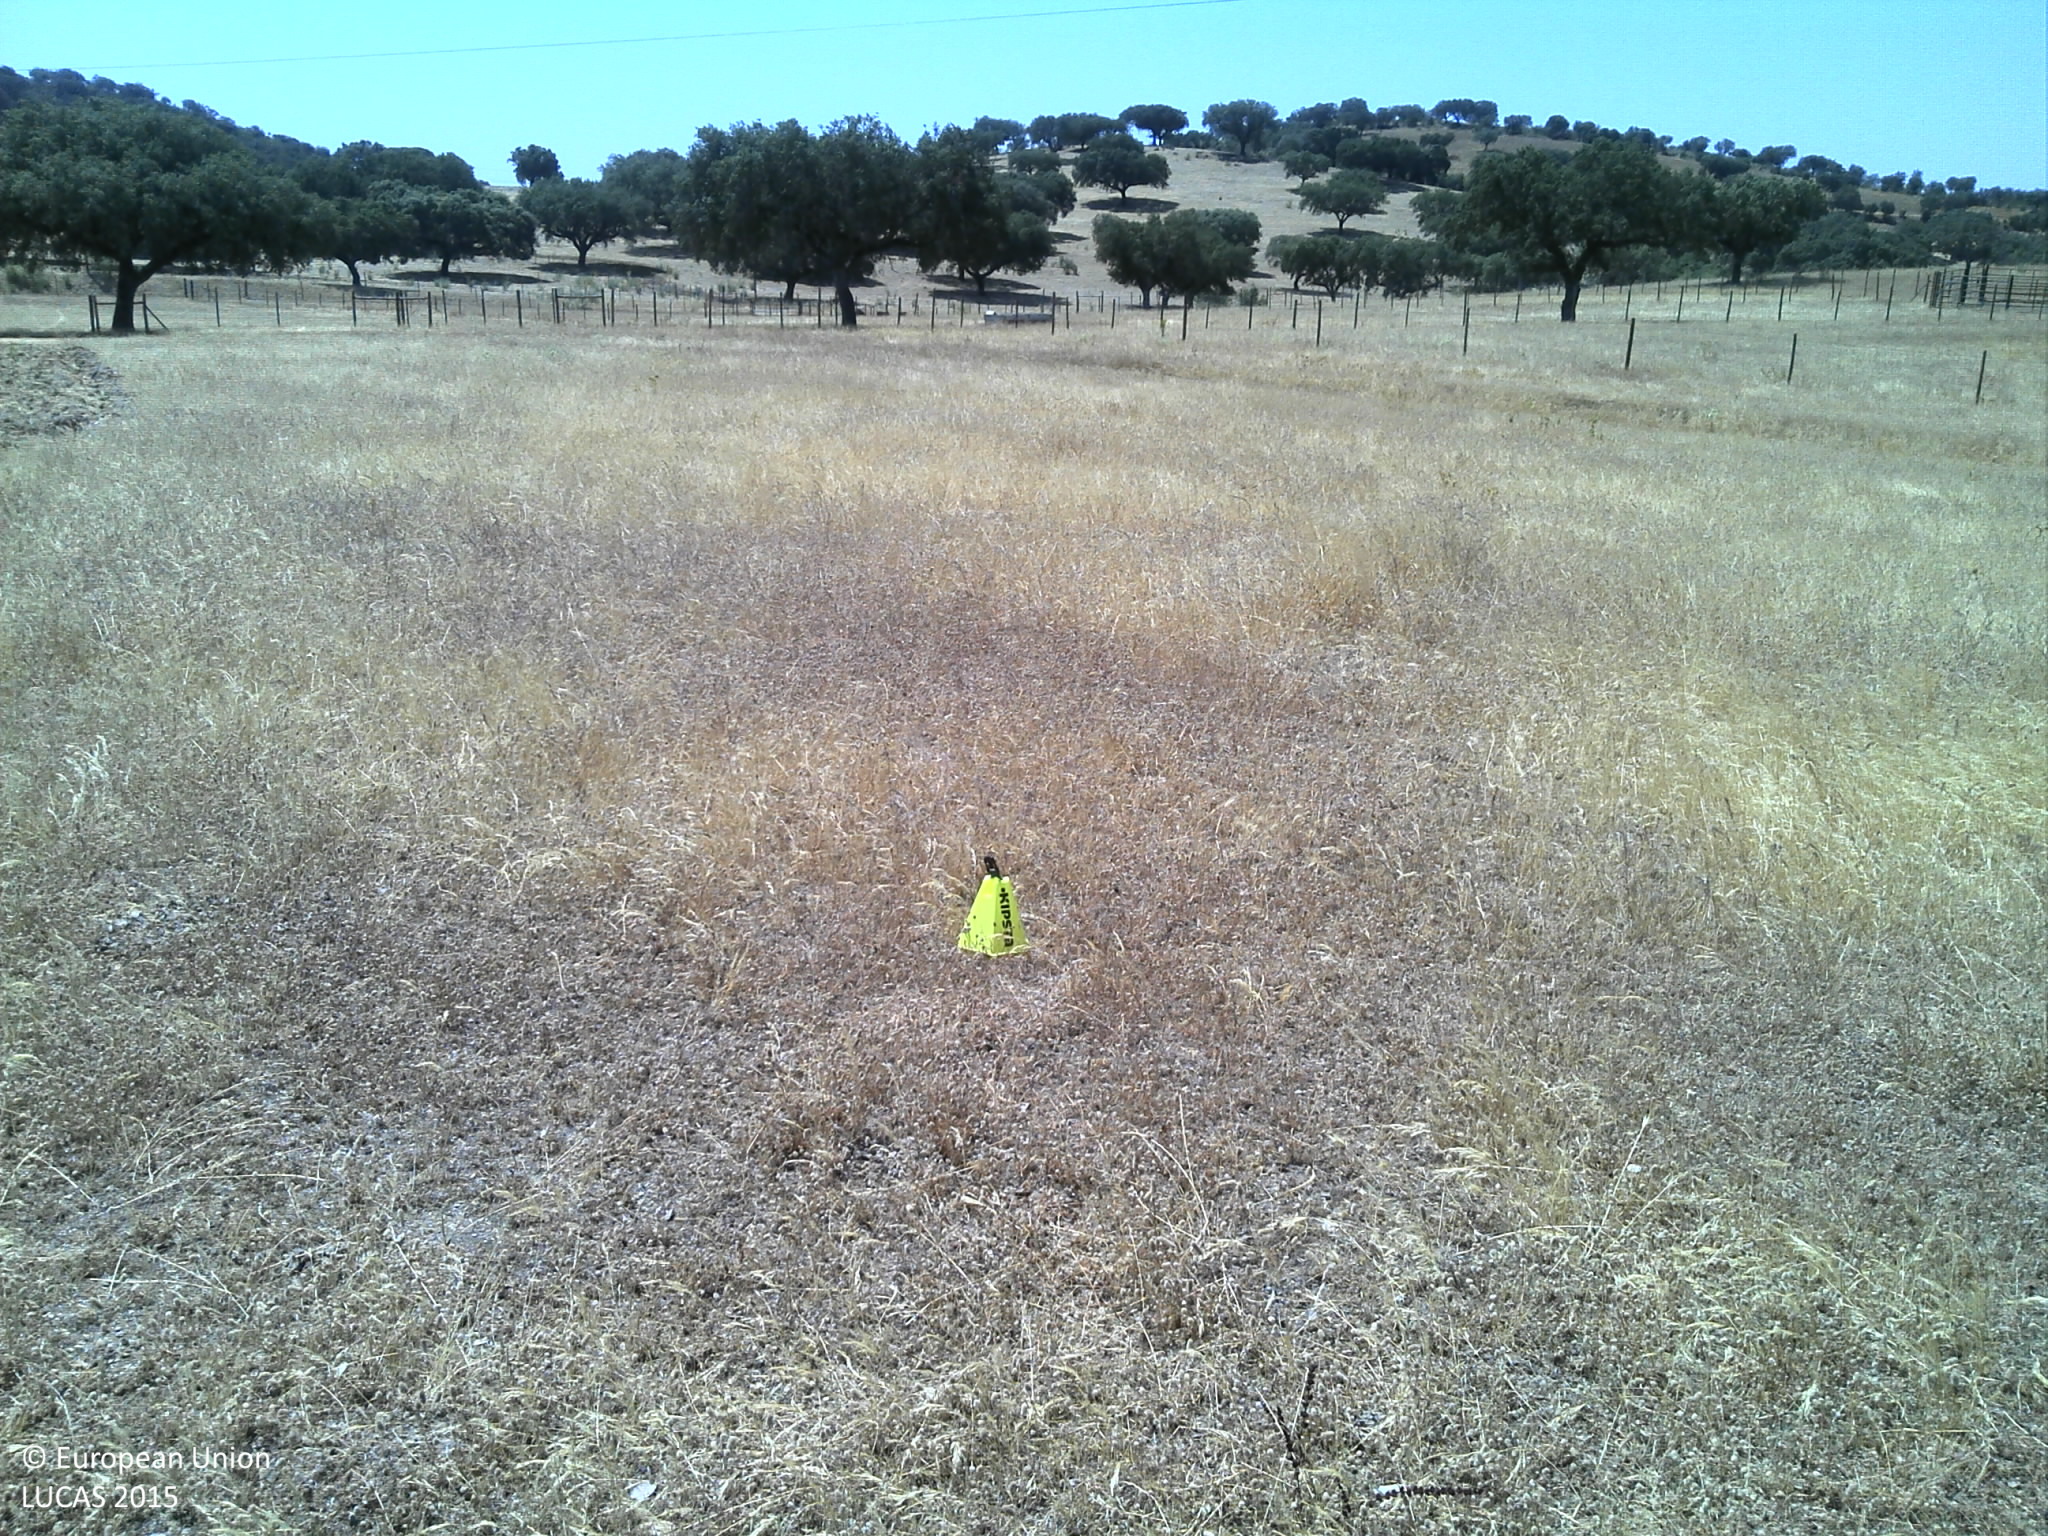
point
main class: Grassland
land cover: Grassland without tree/shrub cover
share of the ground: 10 - 25 %
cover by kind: unconsolidated bare surface 90 %, herbaceous plants 10 %
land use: Agriculture (excluding fallow land and kitchen gardens)
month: July
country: PT
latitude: 38.6496
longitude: -7.3670
